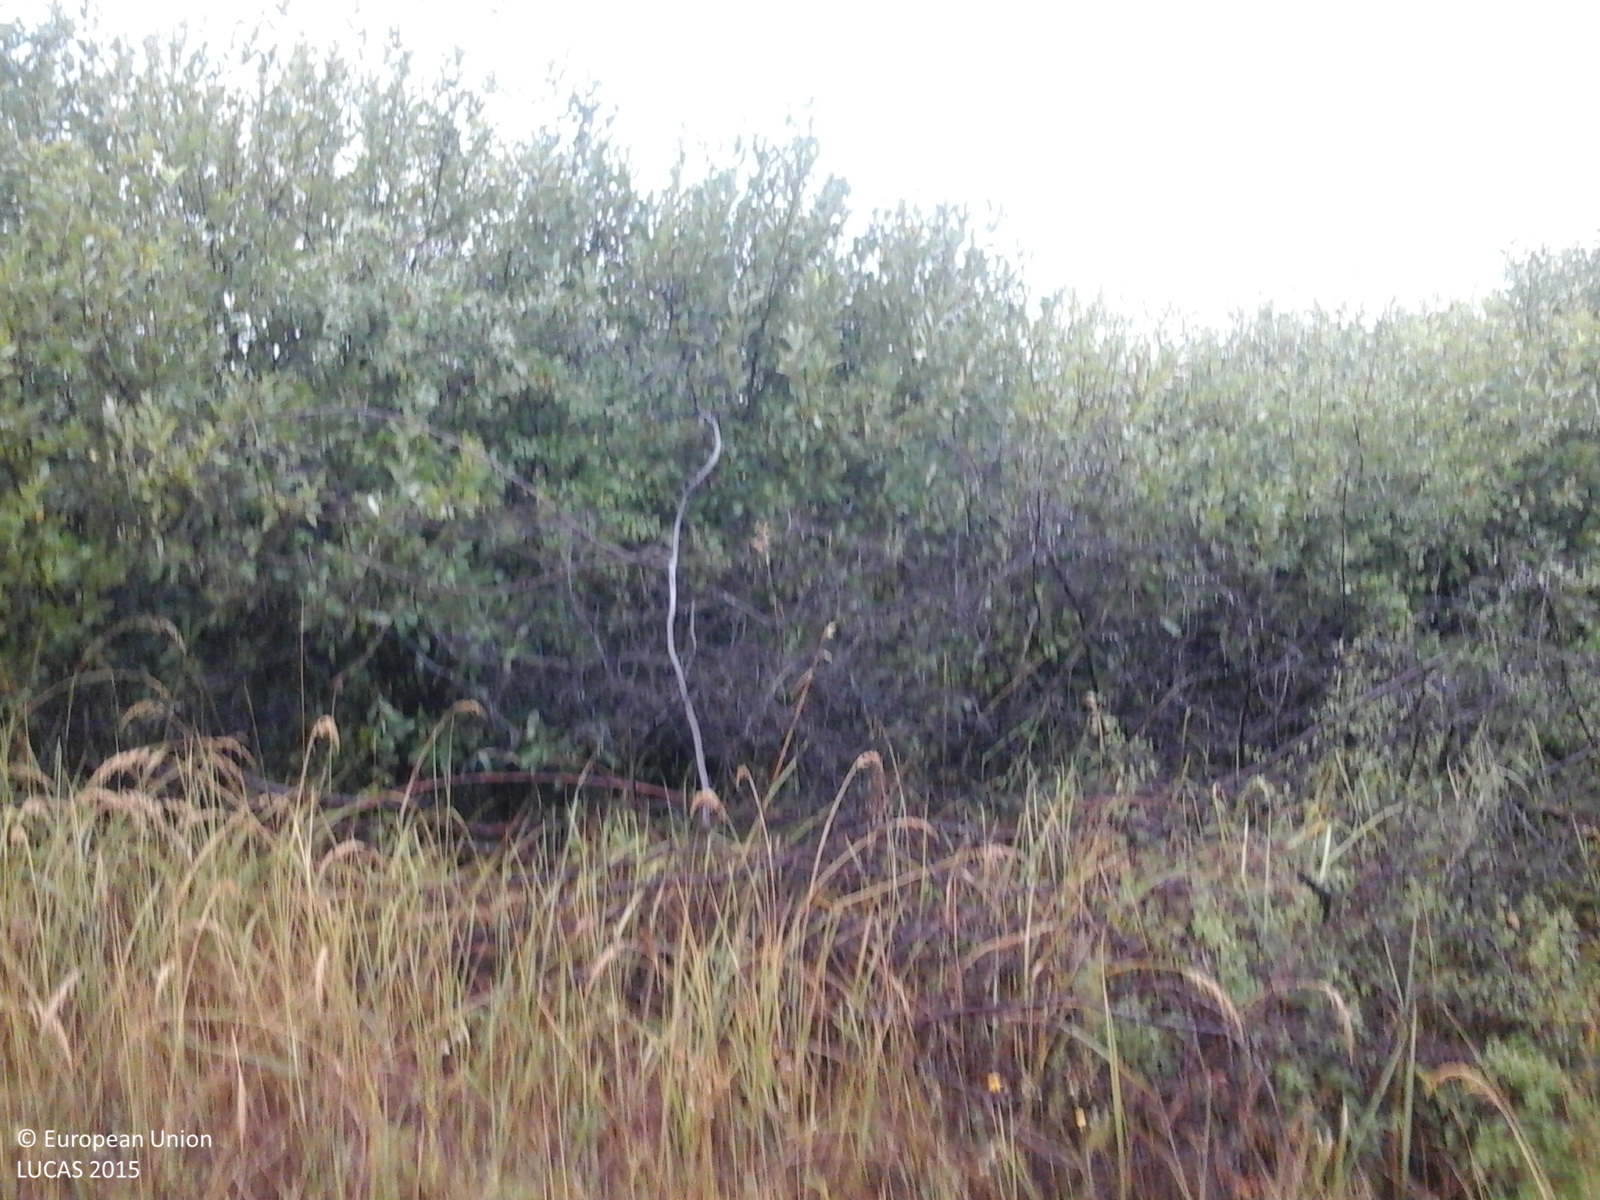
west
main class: Grassland
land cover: Grassland without tree/shrub cover
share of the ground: > 75 %
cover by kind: herbaceous plants 100 %
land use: Agriculture (excluding fallow land and kitchen gardens)
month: August
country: RO
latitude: 45.7088
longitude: 21.3483
